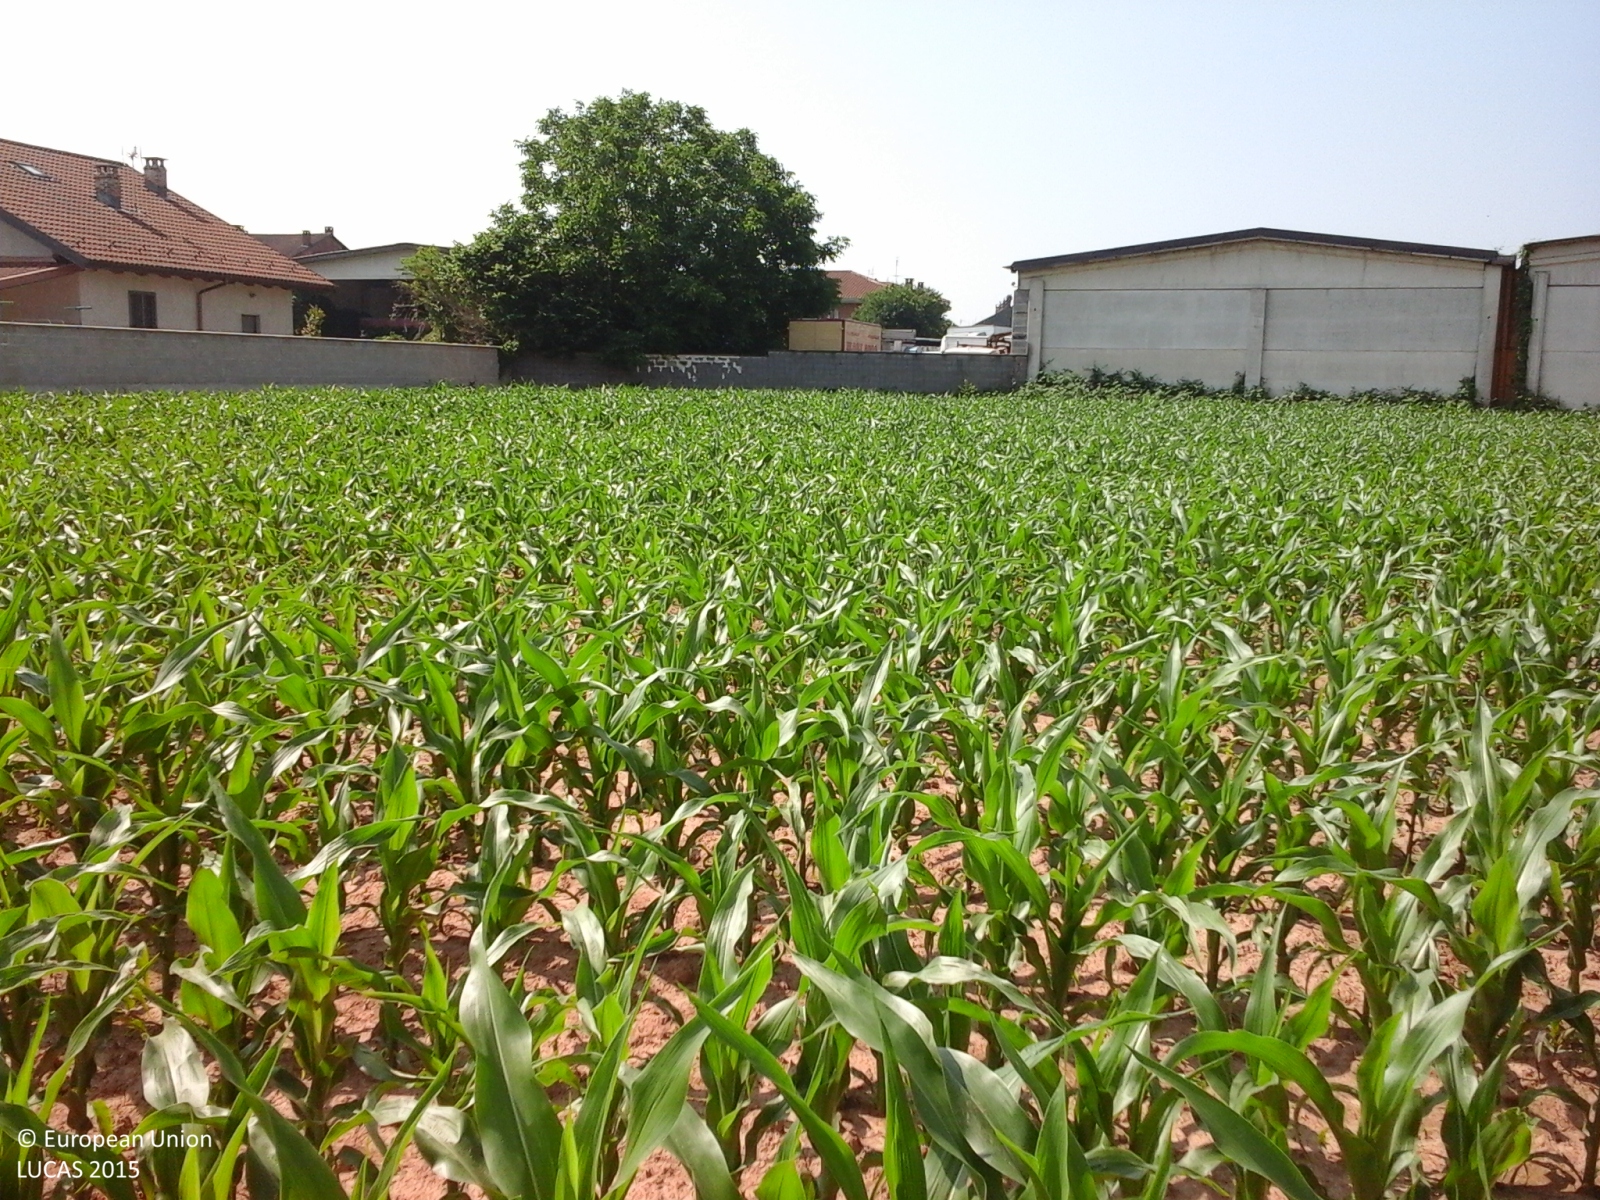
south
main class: Cropland
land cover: Maize
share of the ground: > 75 %
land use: Agriculture (excluding fallow land and kitchen gardens)
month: June
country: IT
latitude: 44.9763
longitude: 7.7849
